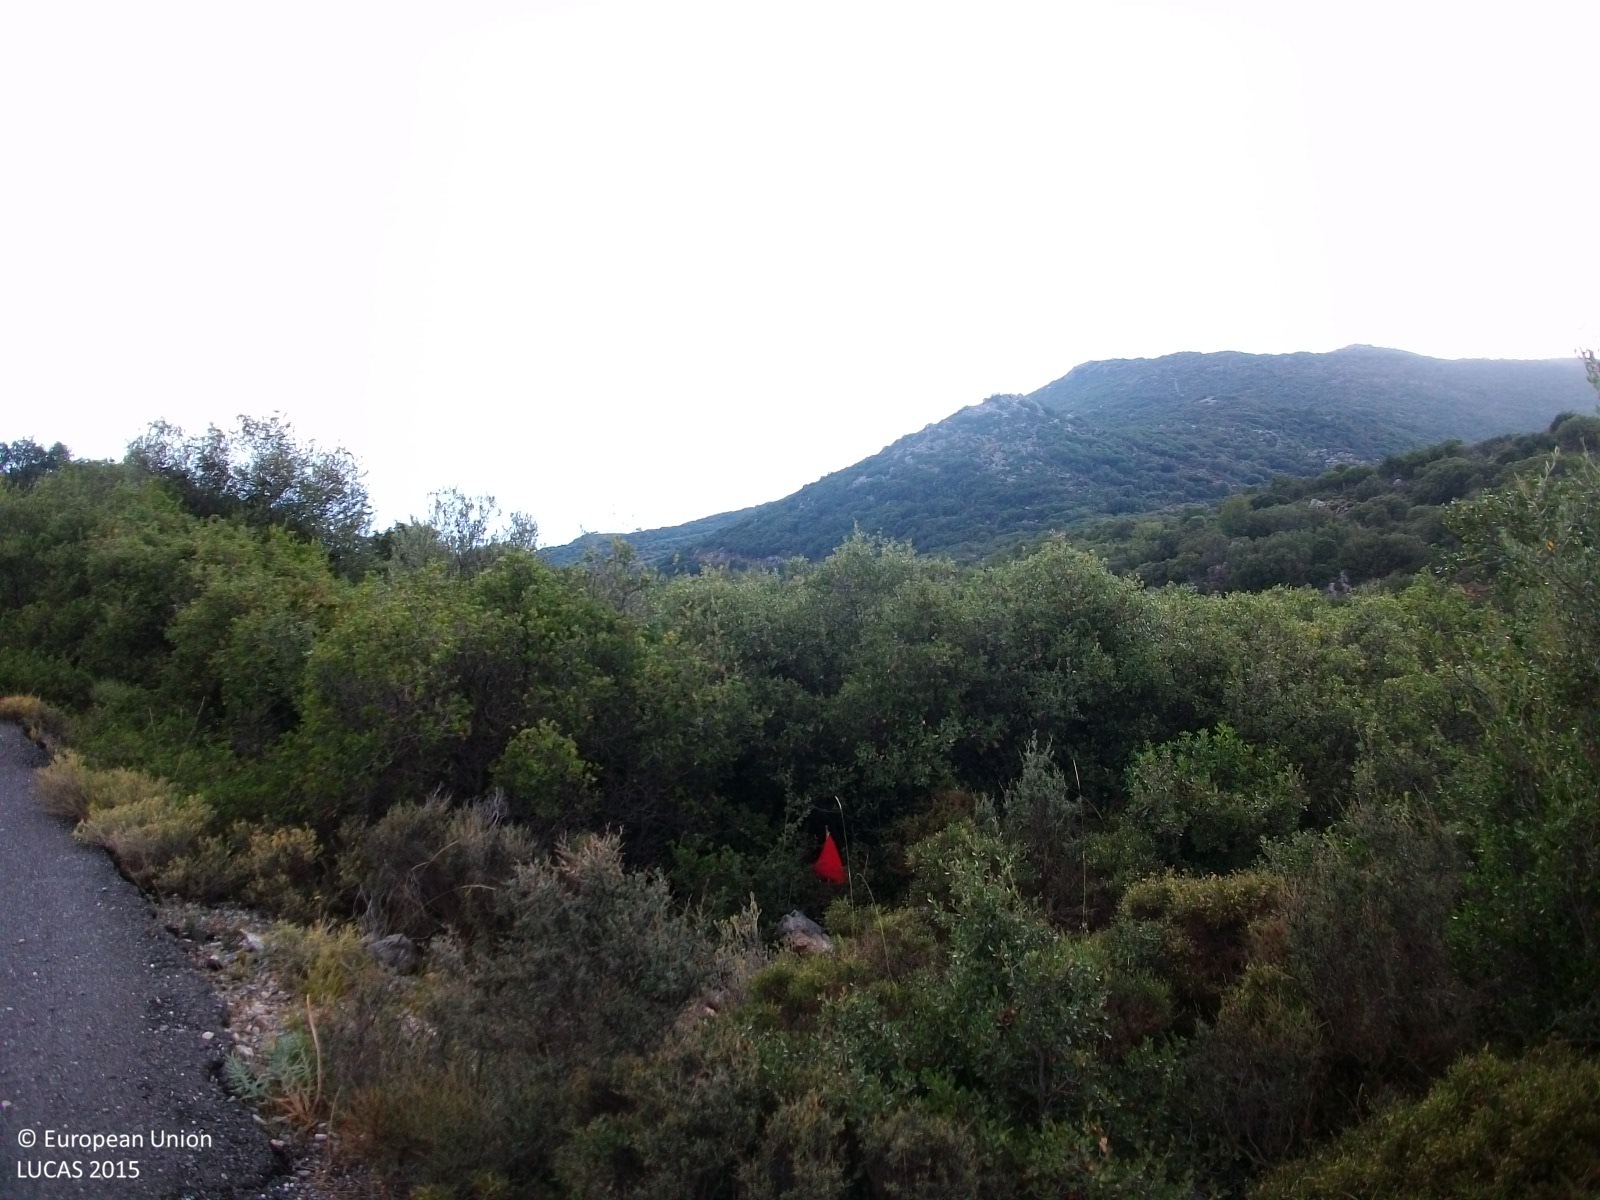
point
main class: Shrubland
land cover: Shrubland without tree cover
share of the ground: > 75 %
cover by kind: shrubs 90 %, unconsolidated bare surface 10 %
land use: Semi-natural and natural areas not in use
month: August
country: GR
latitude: 36.9344
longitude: 22.2468
